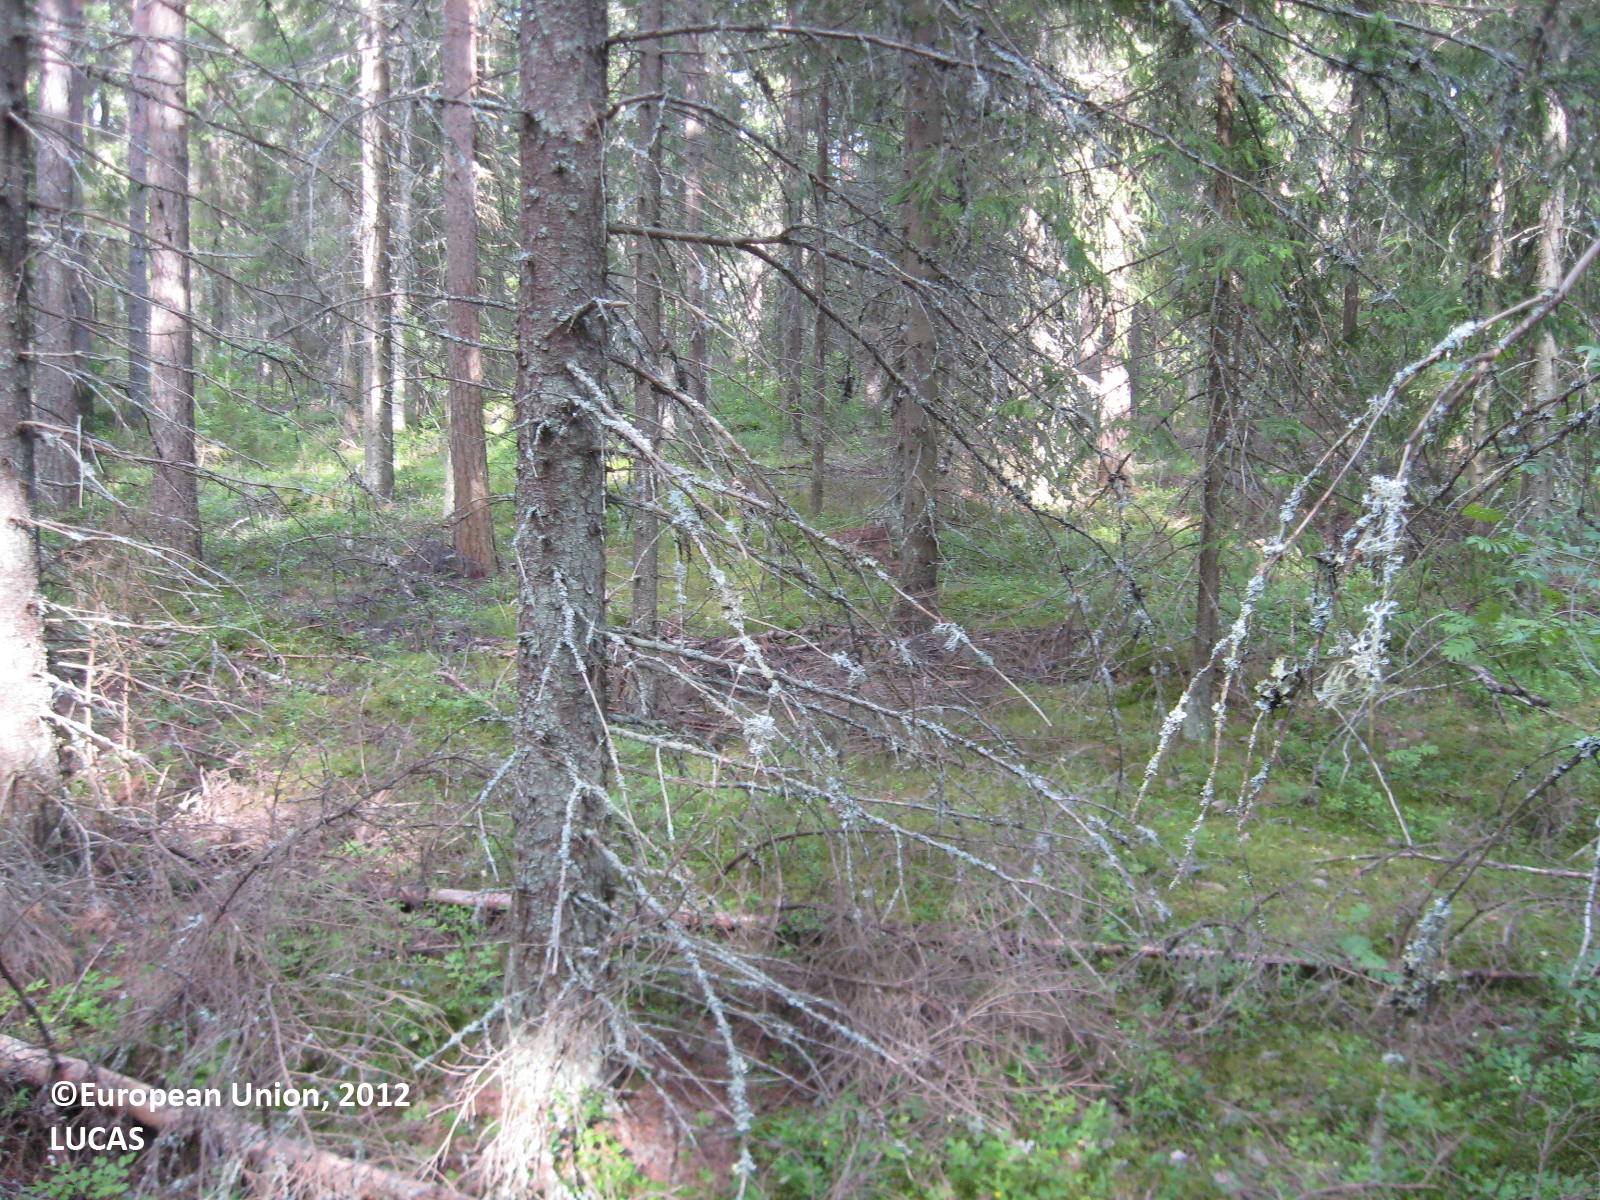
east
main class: Woodland
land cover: Spruce dominated coniferous woodland
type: boreal forest
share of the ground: > 75 %
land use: Forestry
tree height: > 5 m
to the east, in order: Spruce dominated coniferous woodland; Pine dominated coniferous woodland; Ditches and canals; Pine dominated coniferous woodland
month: July
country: FI
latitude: 62.0396
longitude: 21.5374
